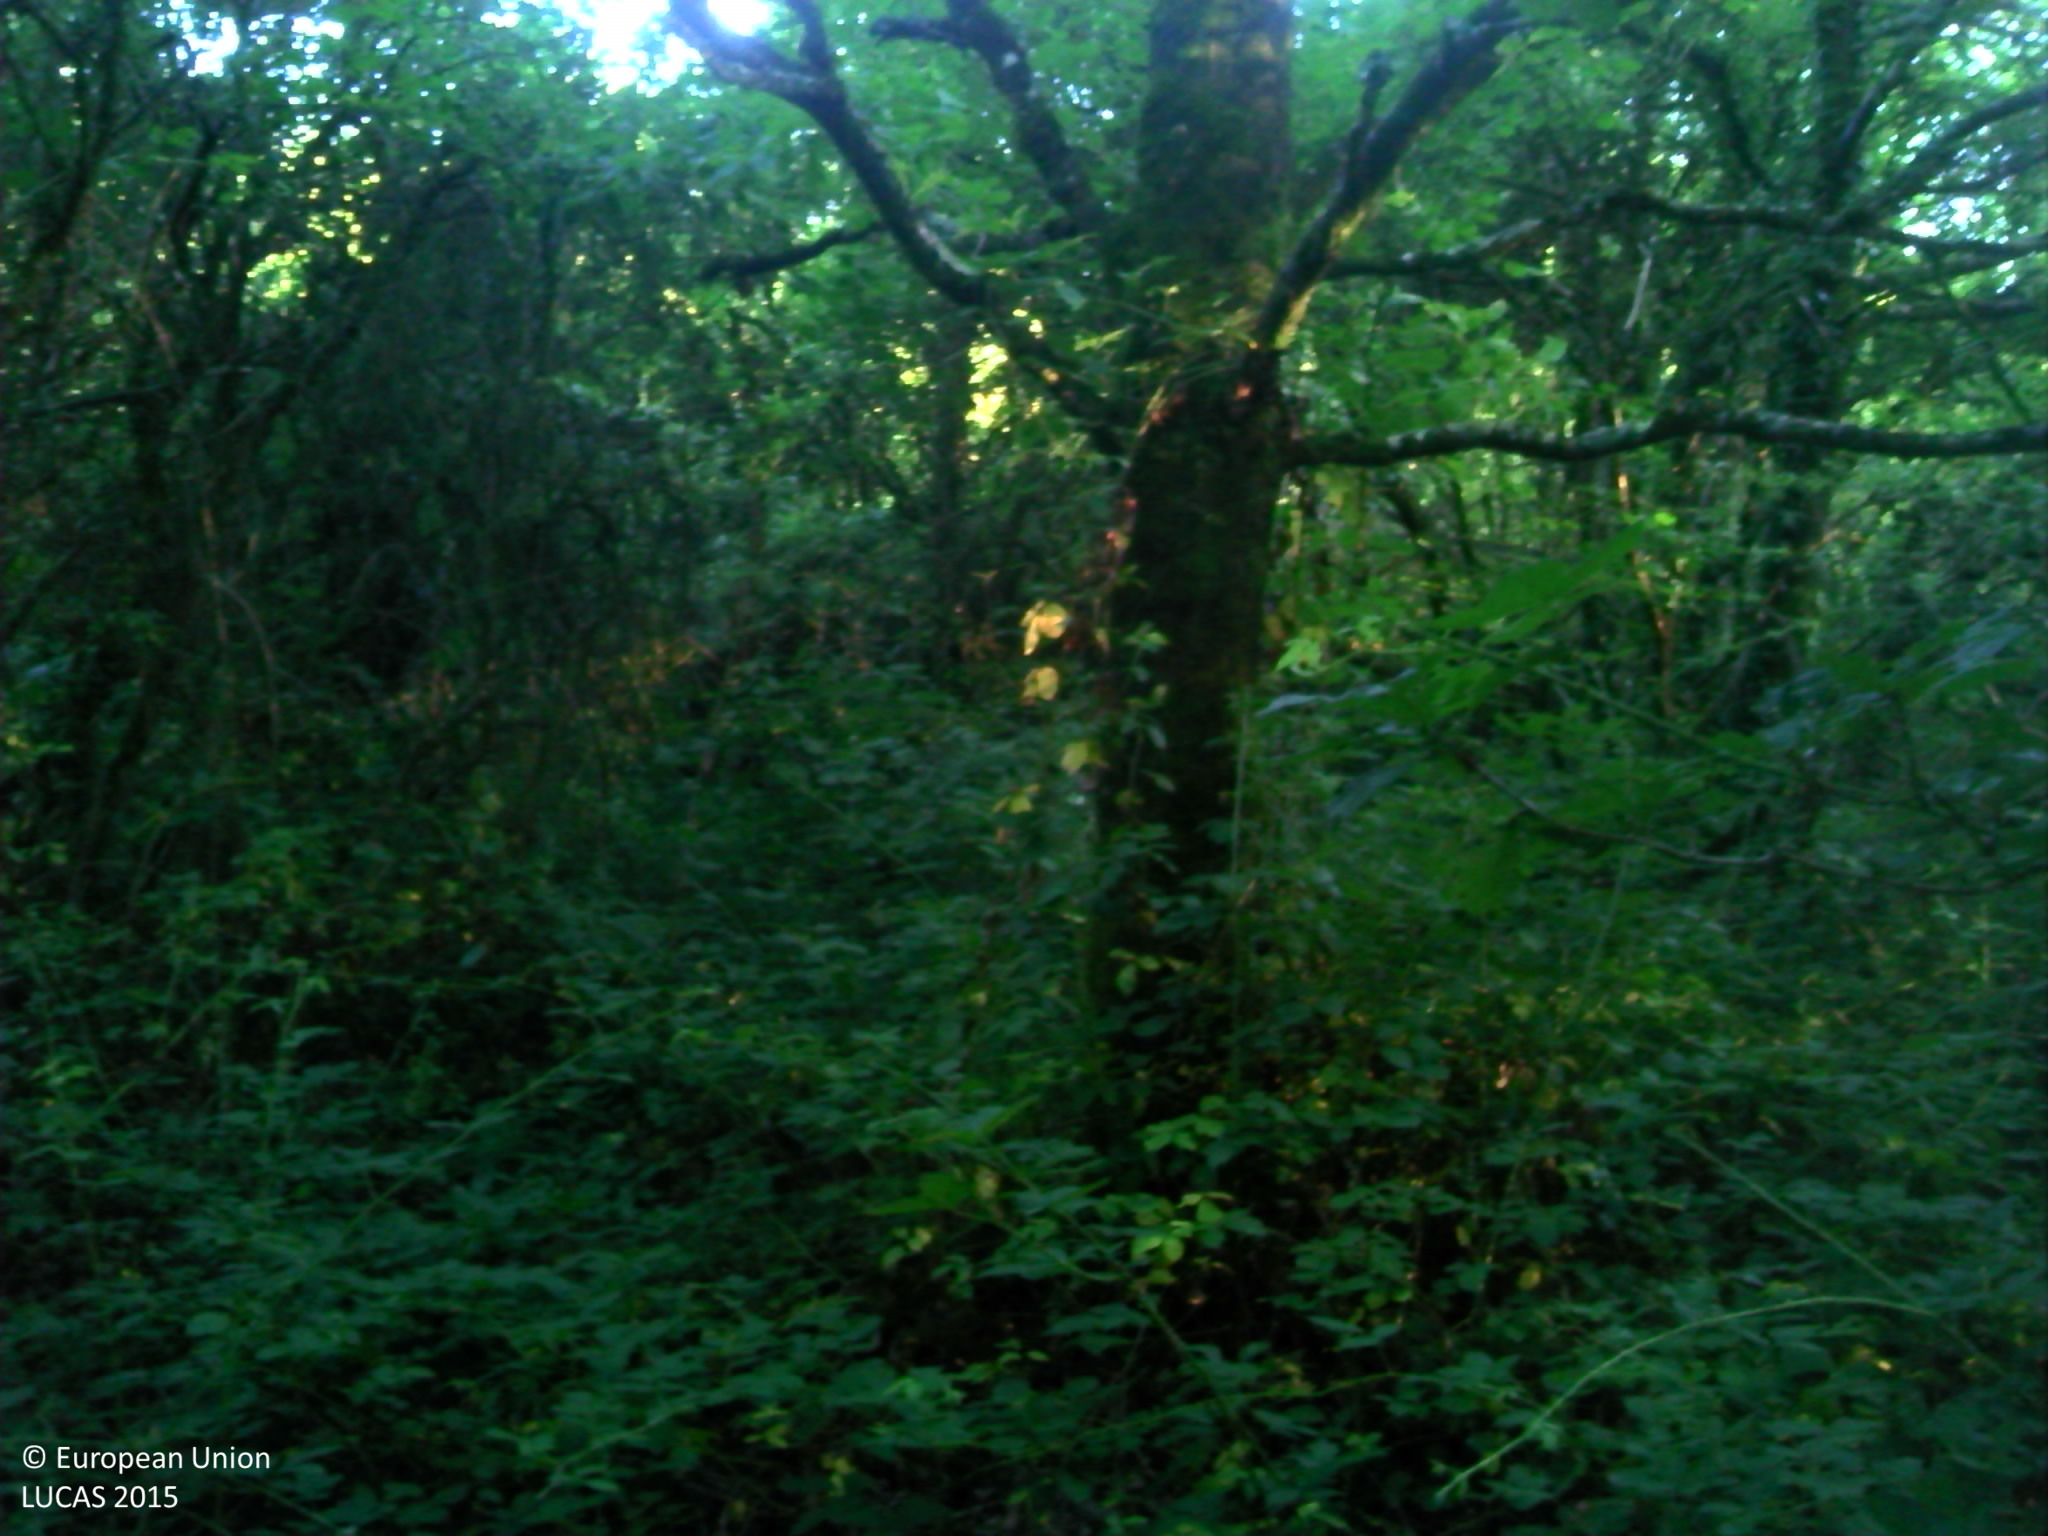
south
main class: Woodland
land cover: Broadleaved woodland
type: mesophytic deciduous forest
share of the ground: > 75 %
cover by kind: broadleaved forest trees 95 %, shrubs 5 %
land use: Forestry
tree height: > 5 m
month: July
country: FR
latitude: 46.8661
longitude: -0.8813
